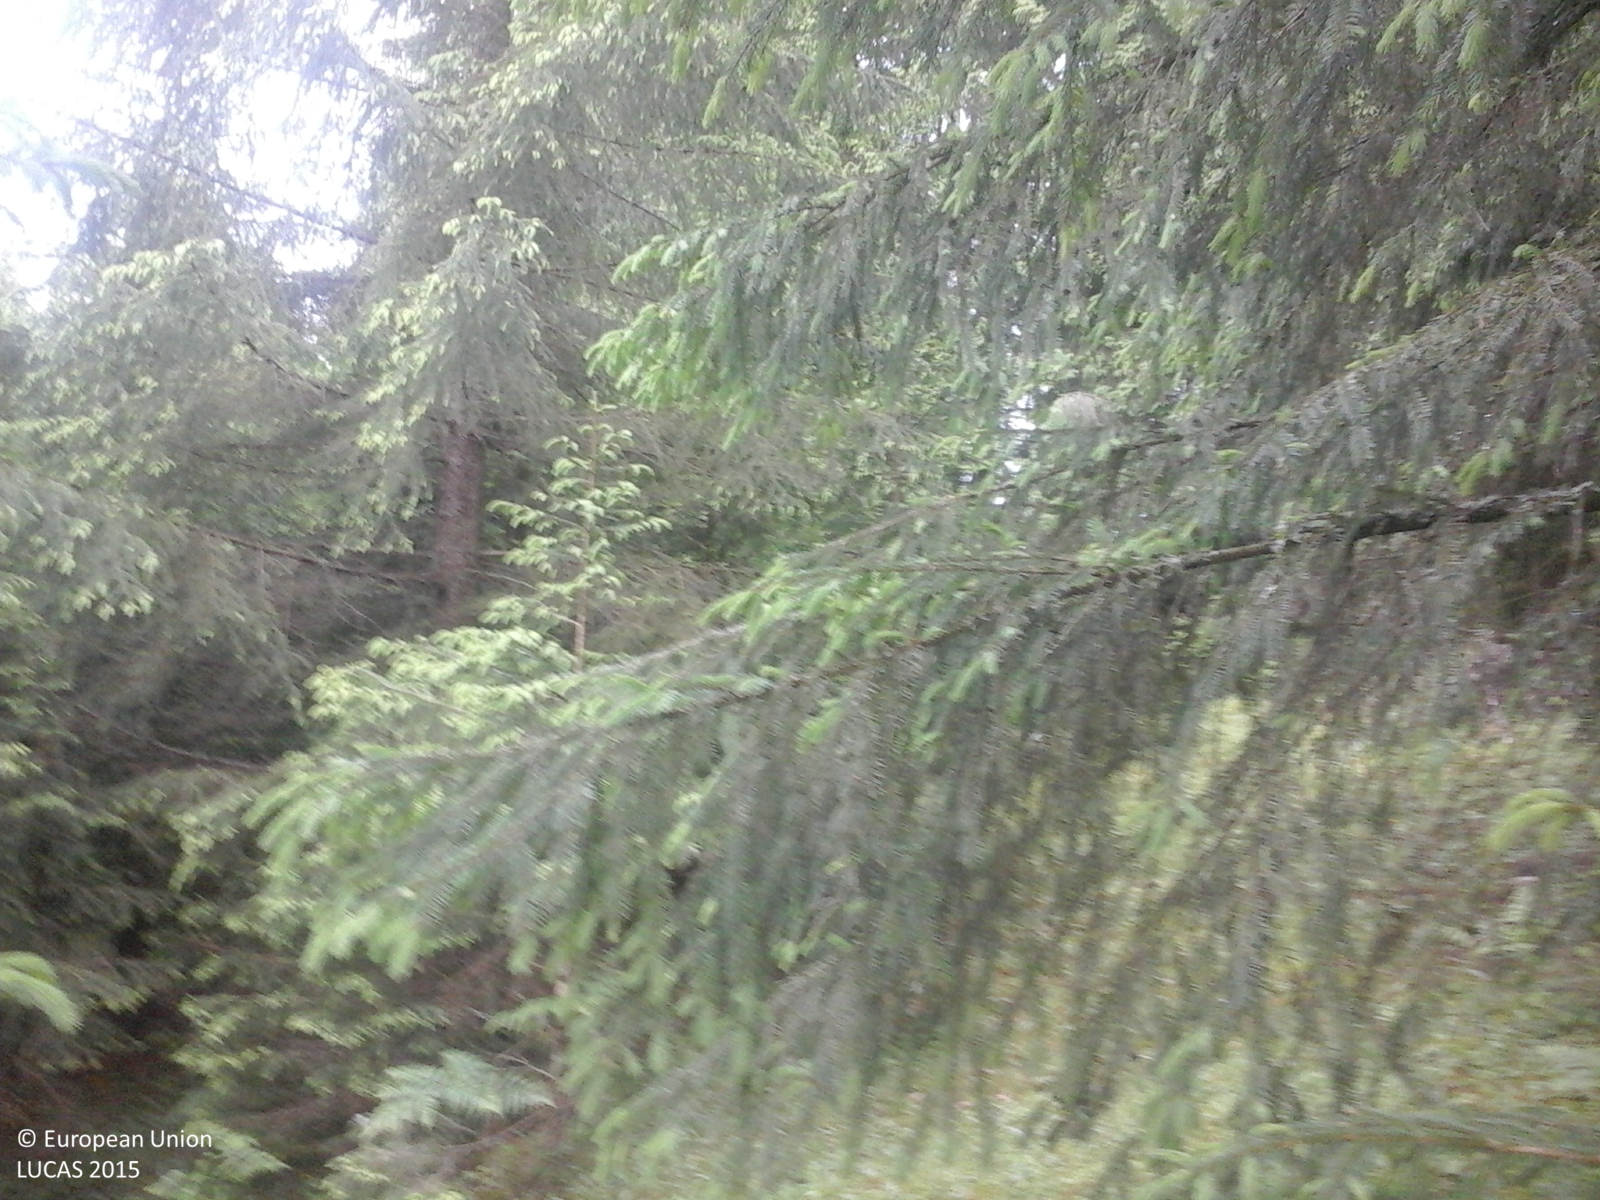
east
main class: Woodland
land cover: Spruce dominated coniferous woodland
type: alpine coniferous forest
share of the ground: > 75 %
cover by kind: coniferous forest trees 85 %, herbaceous plants 10 %, shrubs 5 %
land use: Forestry
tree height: > 5 m
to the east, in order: Spruce dominated coniferous woodland; Fences; Spruce dominated coniferous woodland; Fences; Spruce dominated coniferous woodland; Fences; Lines of trees; Grassland without tree/shrub cover; Fences; Grass margins; Tracks; Grass margins; Fences; Lines of trees; Grassland without tree/shrub cover; Fences; Lines of trees; Grassland without tree/shrub cover
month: June
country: RO
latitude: 47.3680
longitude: 25.1636
